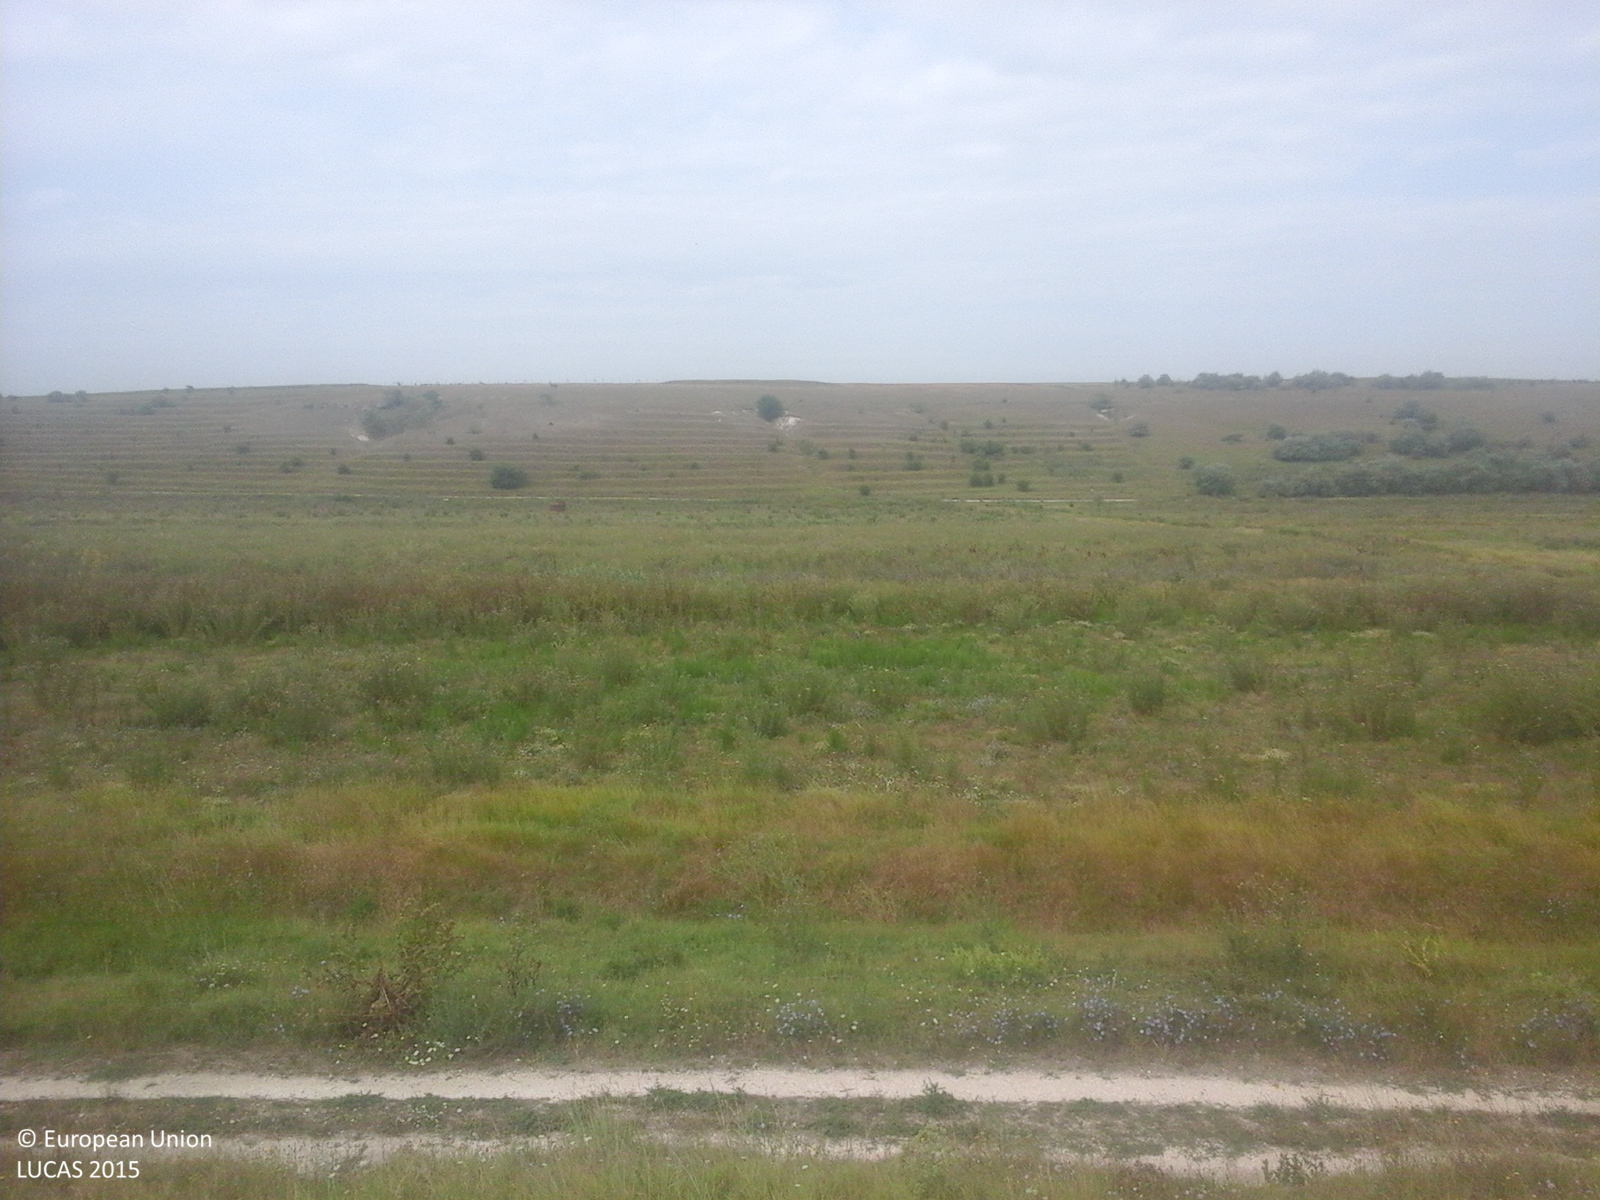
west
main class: Grassland
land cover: Grassland without tree/shrub cover
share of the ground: > 75 %
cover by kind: herbaceous plants 100 %
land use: Agriculture (excluding fallow land and kitchen gardens)
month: August
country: RO
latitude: 43.9623
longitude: 28.1912
